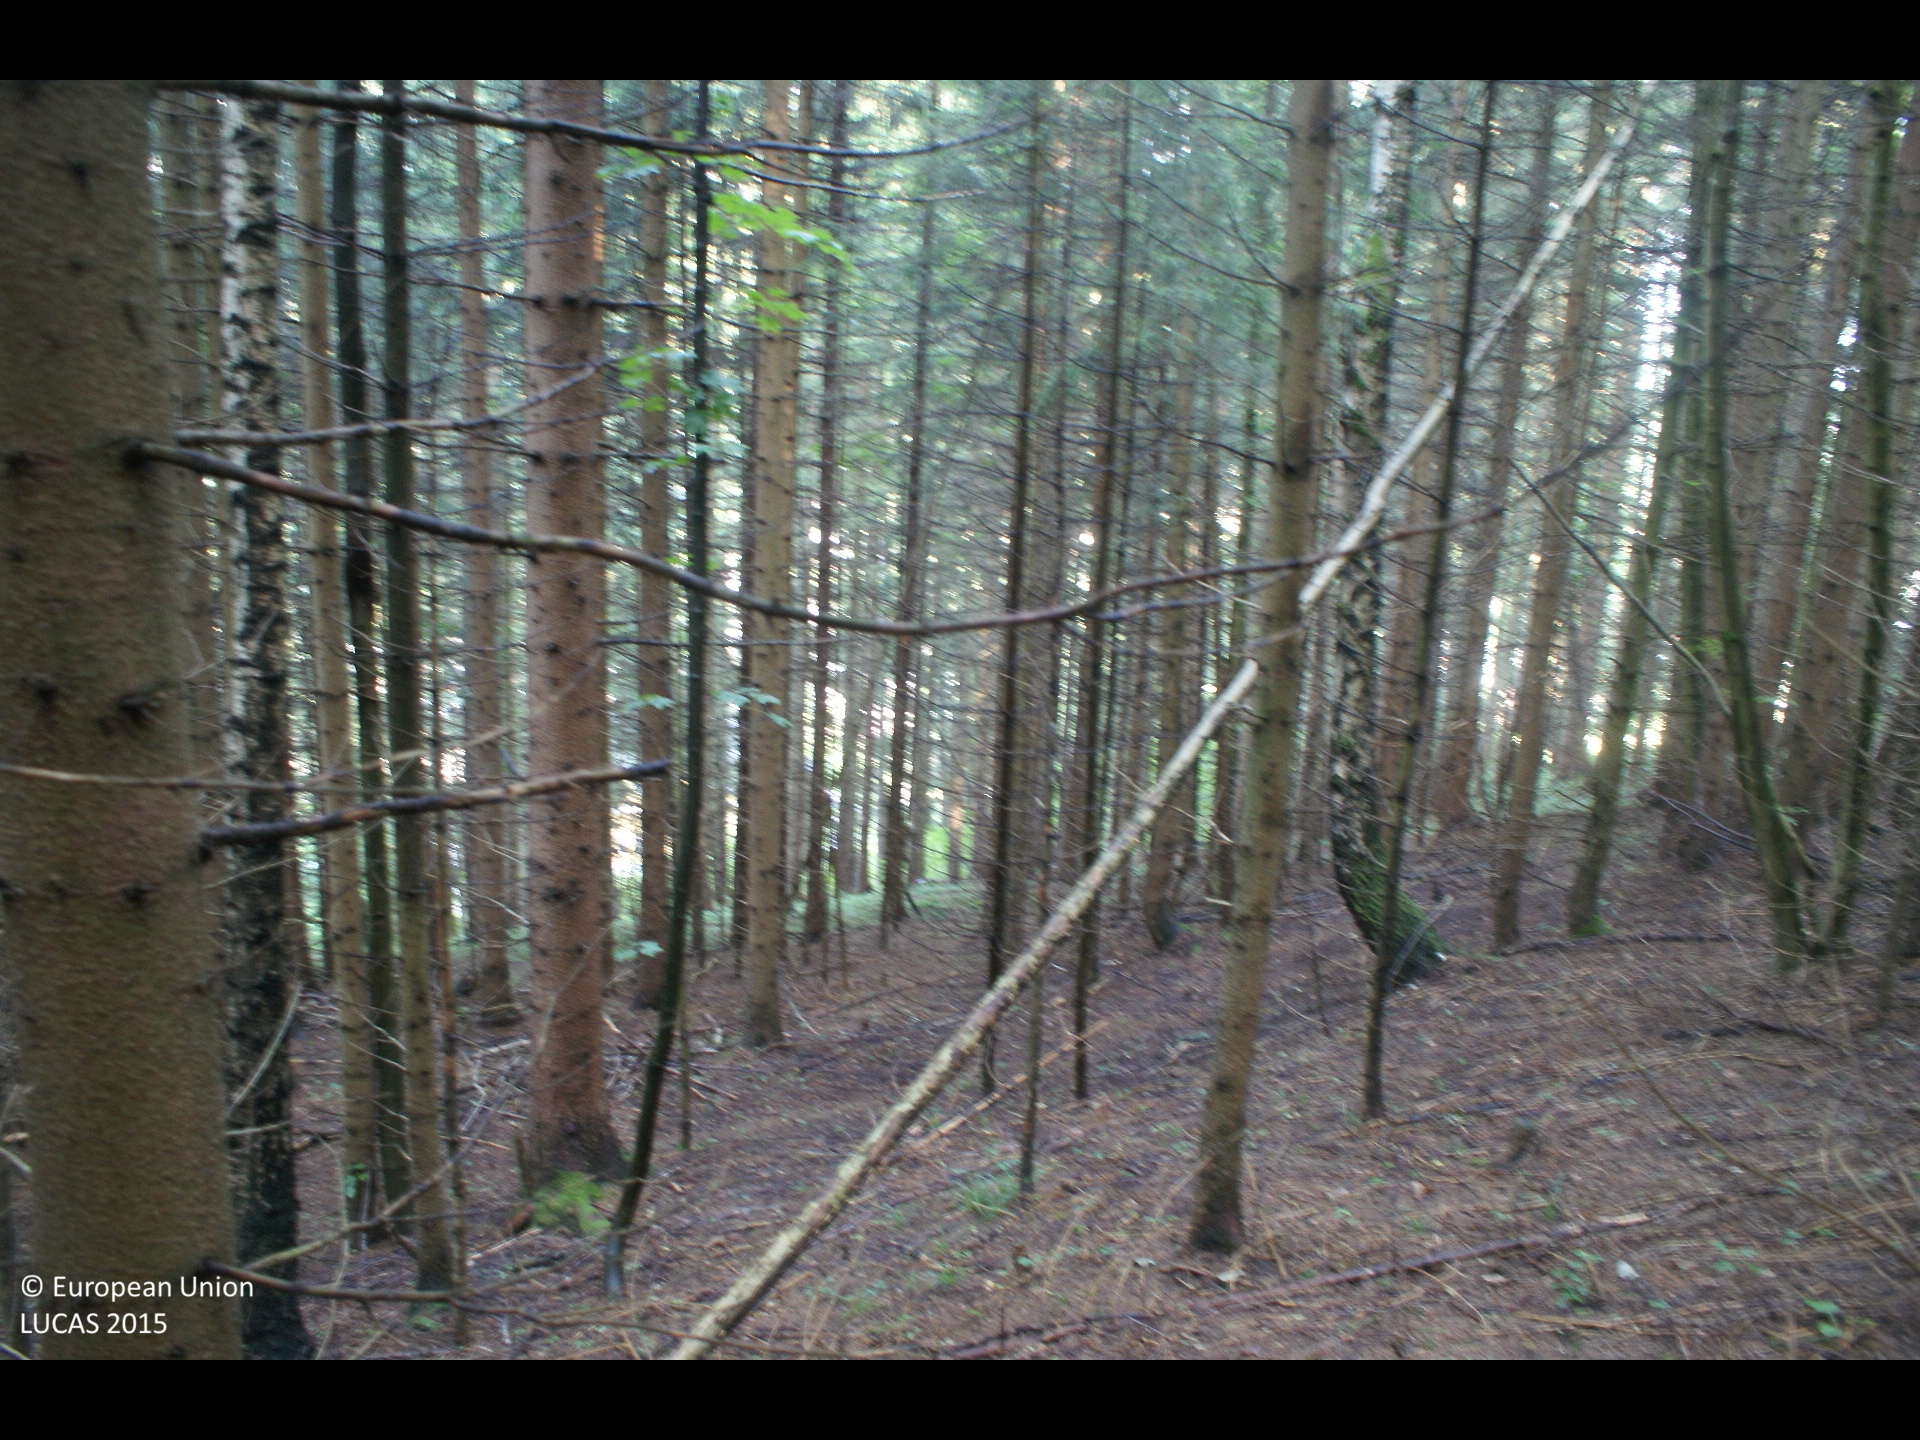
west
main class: Woodland
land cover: Spruce dominated coniferous woodland
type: alpine coniferous forest
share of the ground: > 75 %
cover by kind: coniferous forest trees 90 %, unconsolidated bare surface 10 %
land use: Forestry
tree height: > 5 m
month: July
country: AT
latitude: 47.7702
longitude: 15.3252
